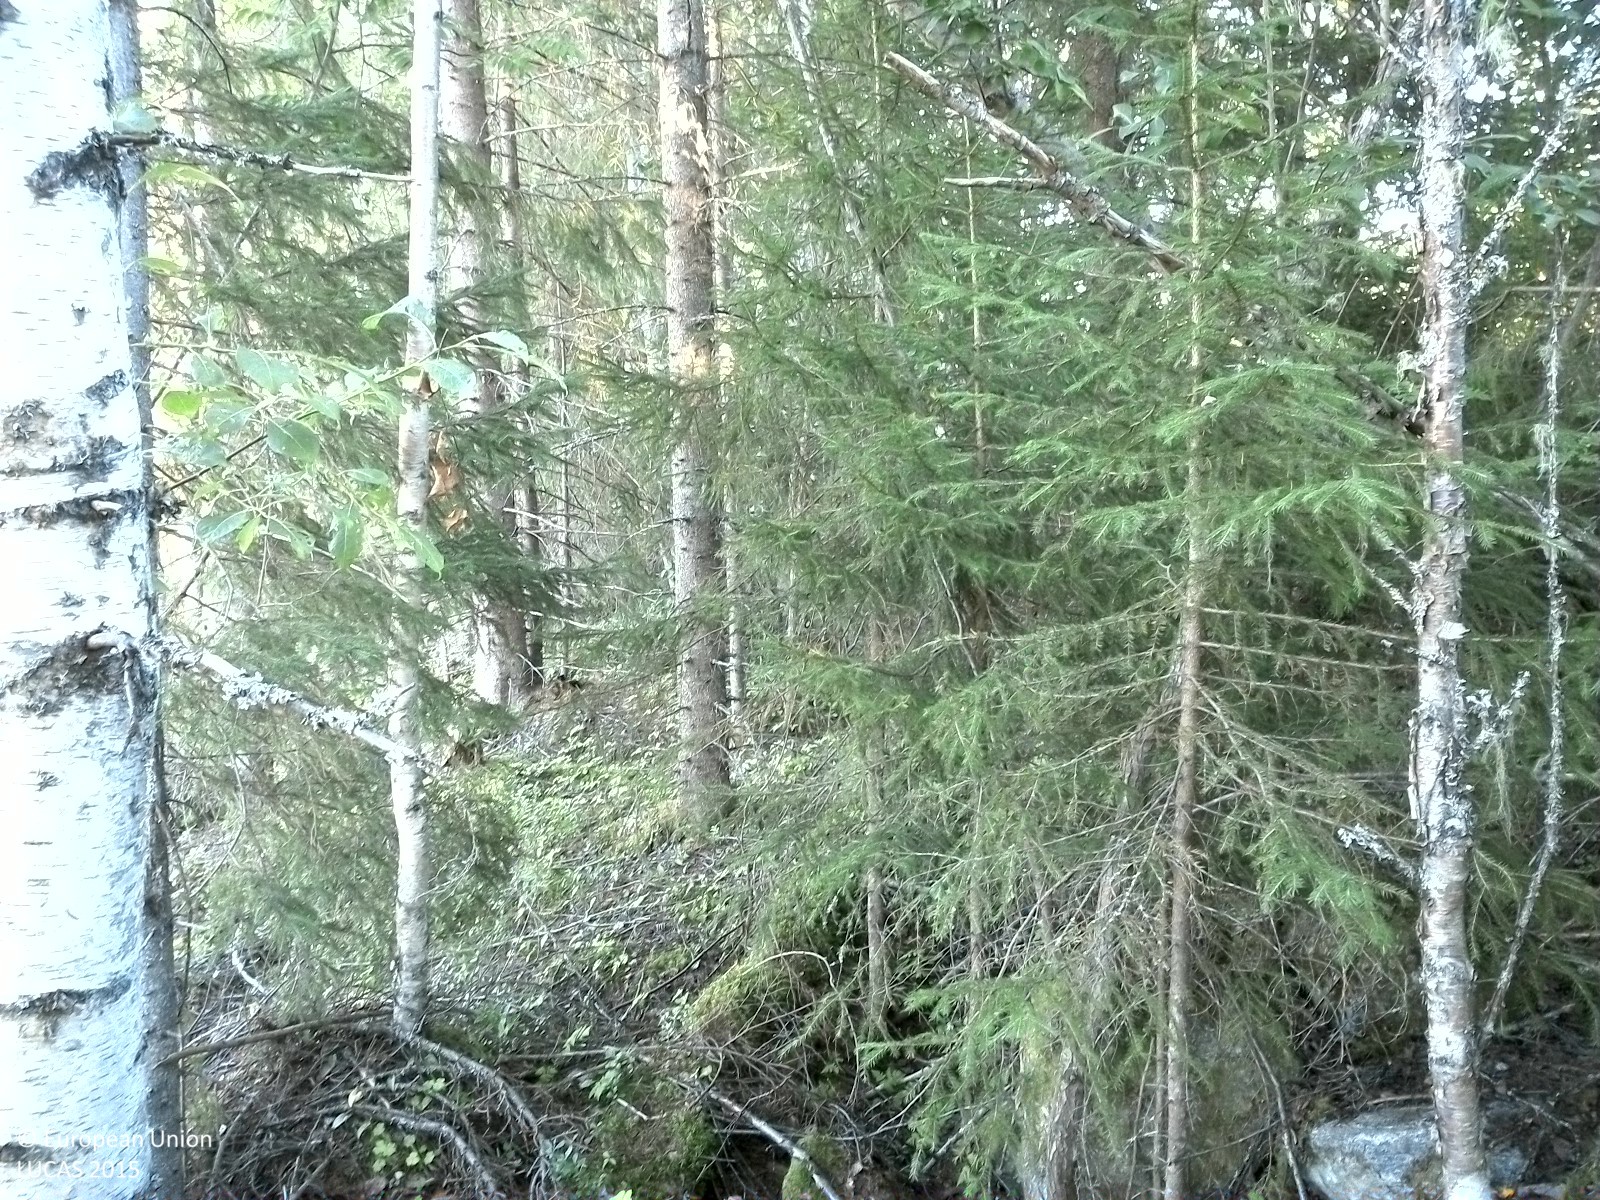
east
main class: Woodland
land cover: Spruce dominated mixed woodland
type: boreal forest
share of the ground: > 75 %
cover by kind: broadleaved forest trees 40 %, coniferous forest trees 35 %, lichens and mosses 15 %, herbaceous plants 10 %
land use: Forestry
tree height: > 5 m
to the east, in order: Spruce dominated mixed woodland; Shrubland without tree cover; Spruce dominated mixed woodland; Other mixed woodland
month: August
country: SE
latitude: 62.3850
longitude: 16.4194
